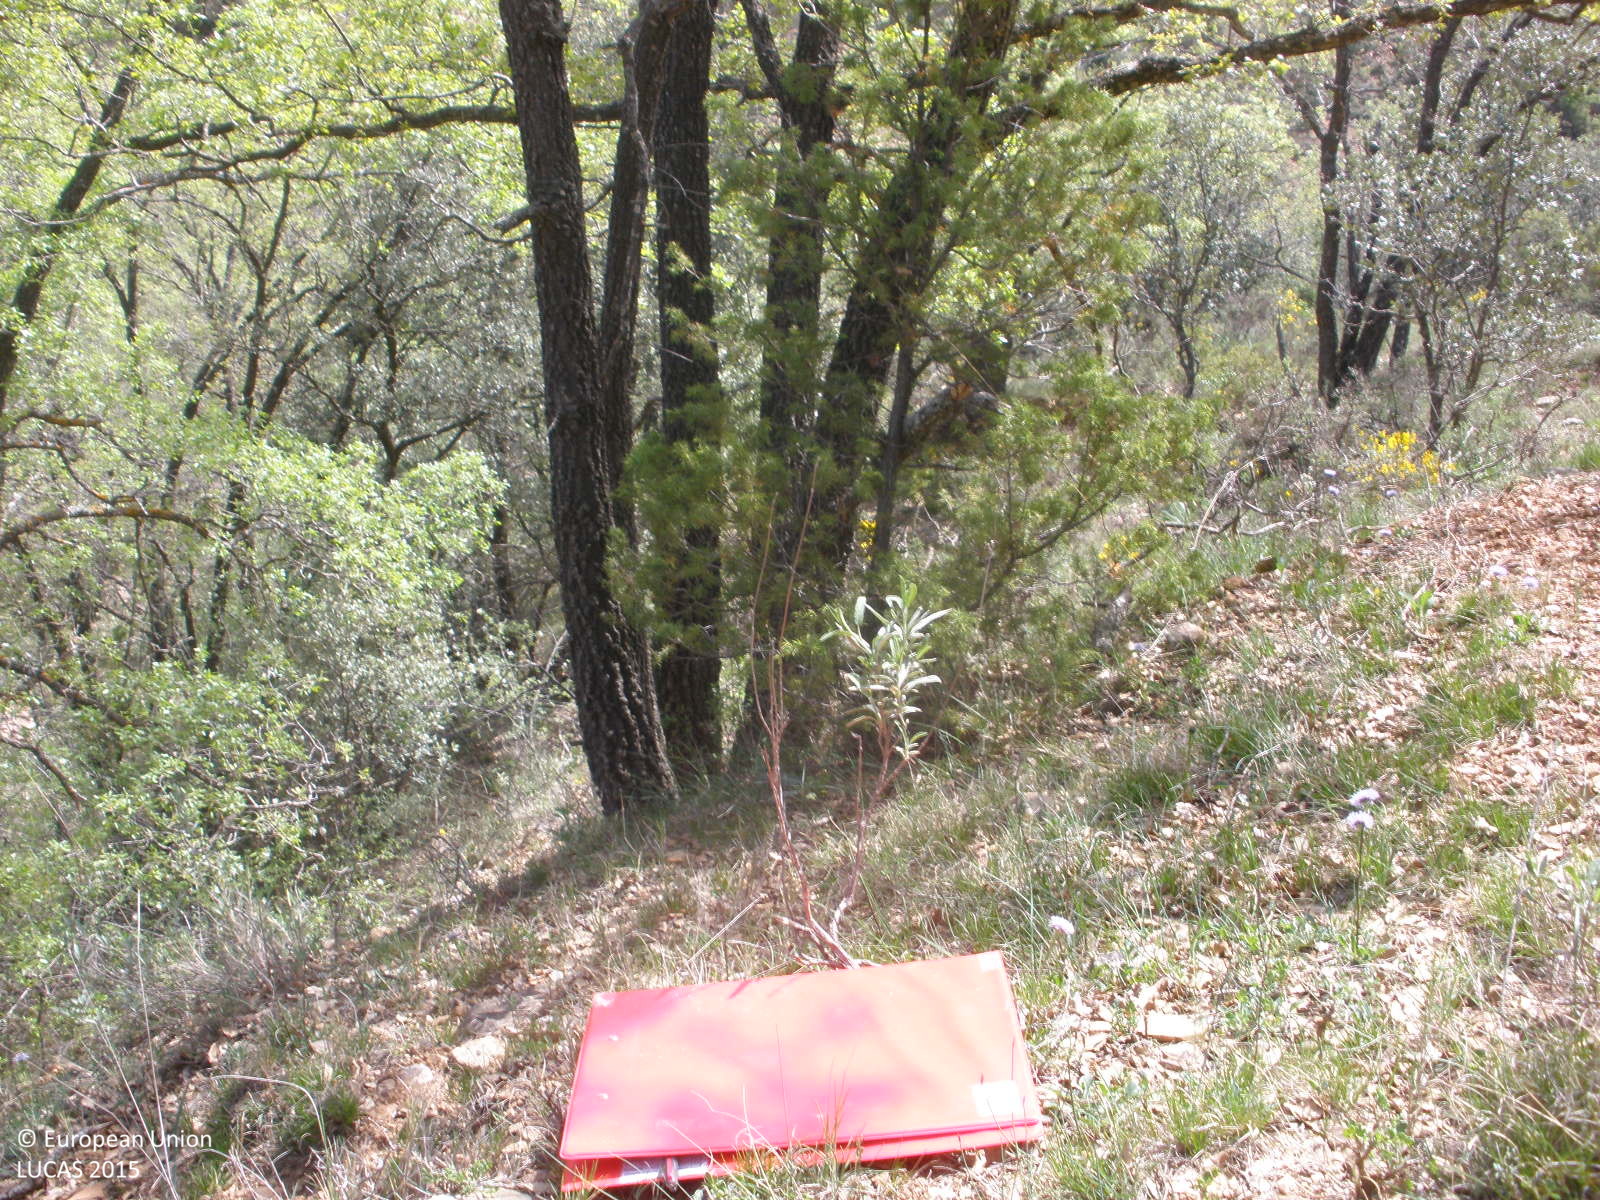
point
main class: Woodland
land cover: Broadleaved woodland
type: broadleaved evergreen forest
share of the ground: > 75 %
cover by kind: broadleaved forest trees 70 %, shrubs 20 %, consolidated bare surface 10 %
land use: Semi-natural and natural areas not in use
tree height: > 5 m
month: May
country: ES
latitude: 40.8777
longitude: -0.9201
